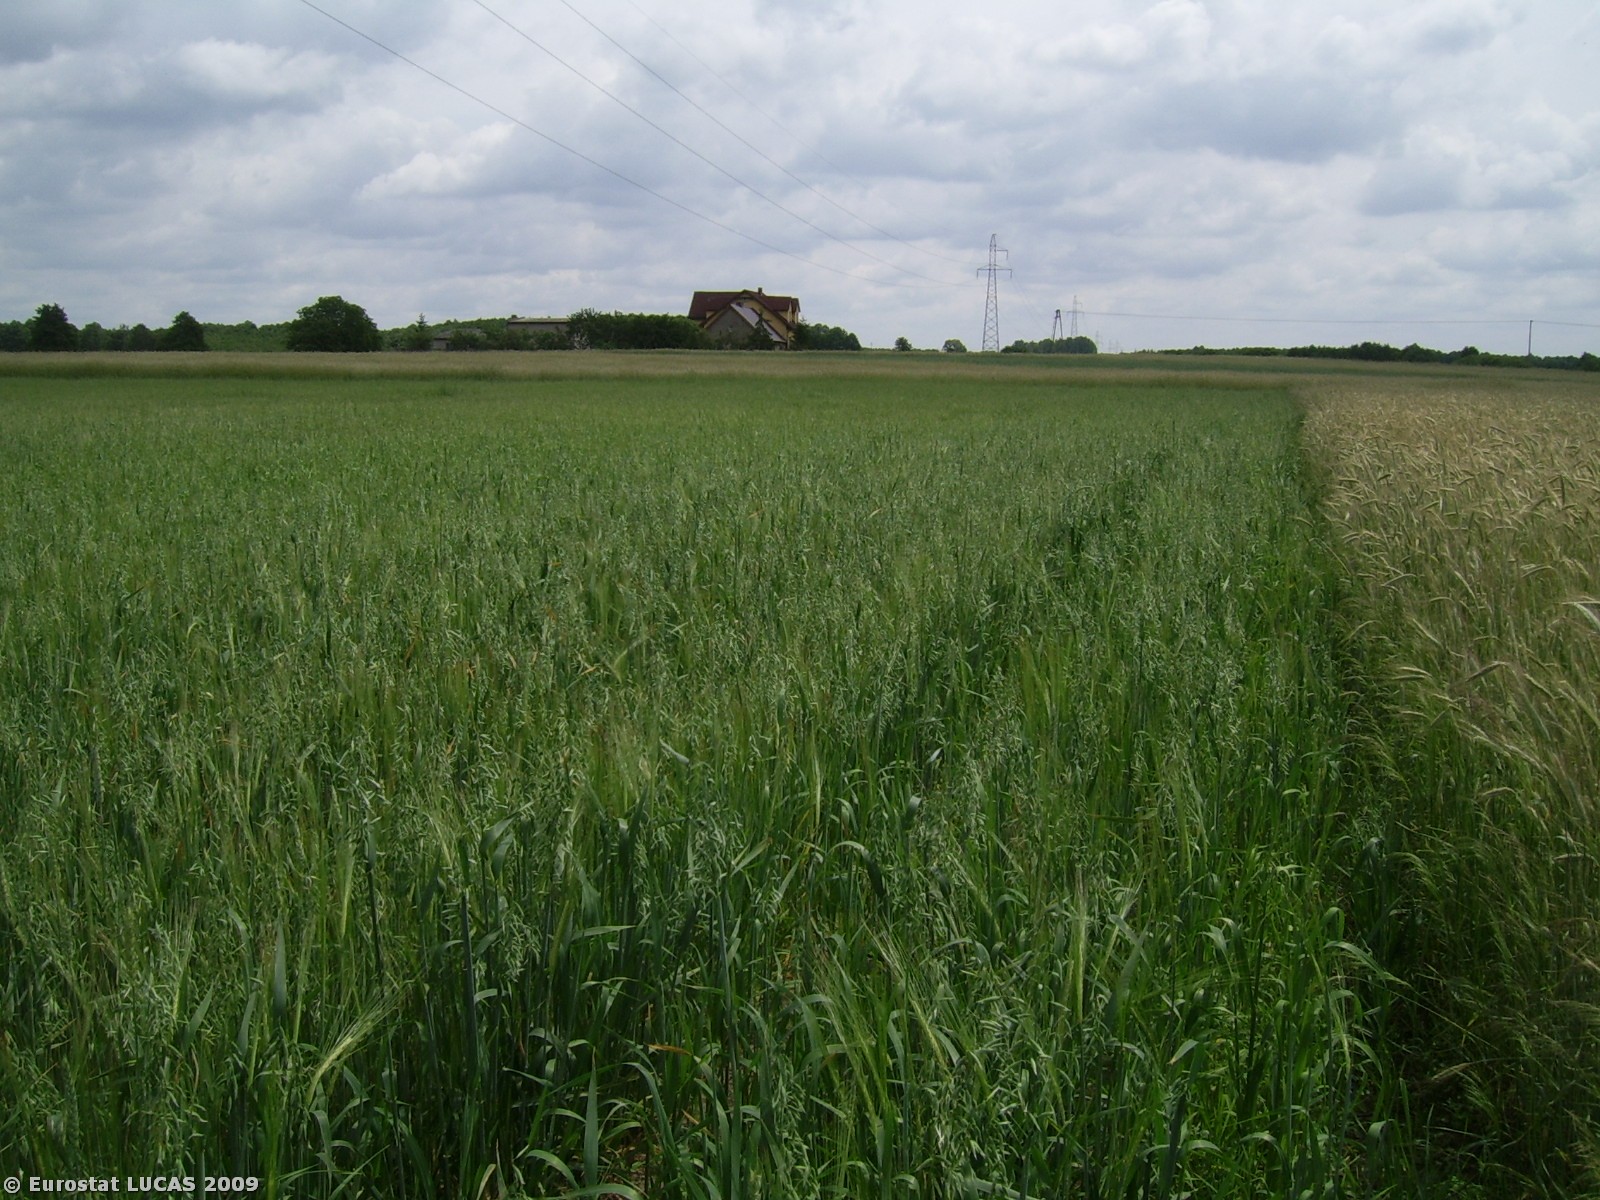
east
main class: Cropland
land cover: Mixed cereals for fodder
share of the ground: > 75 %
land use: Agriculture (excluding fallow land and kitchen gardens)
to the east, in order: Mixed cereals for fodder; Electric lines; Mixed cereals for fodder; Triticale; Artificial constructions in urban areas; Common wheat; Grass margins; Triticale
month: June
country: PL
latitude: 52.4242
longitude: 17.8526
